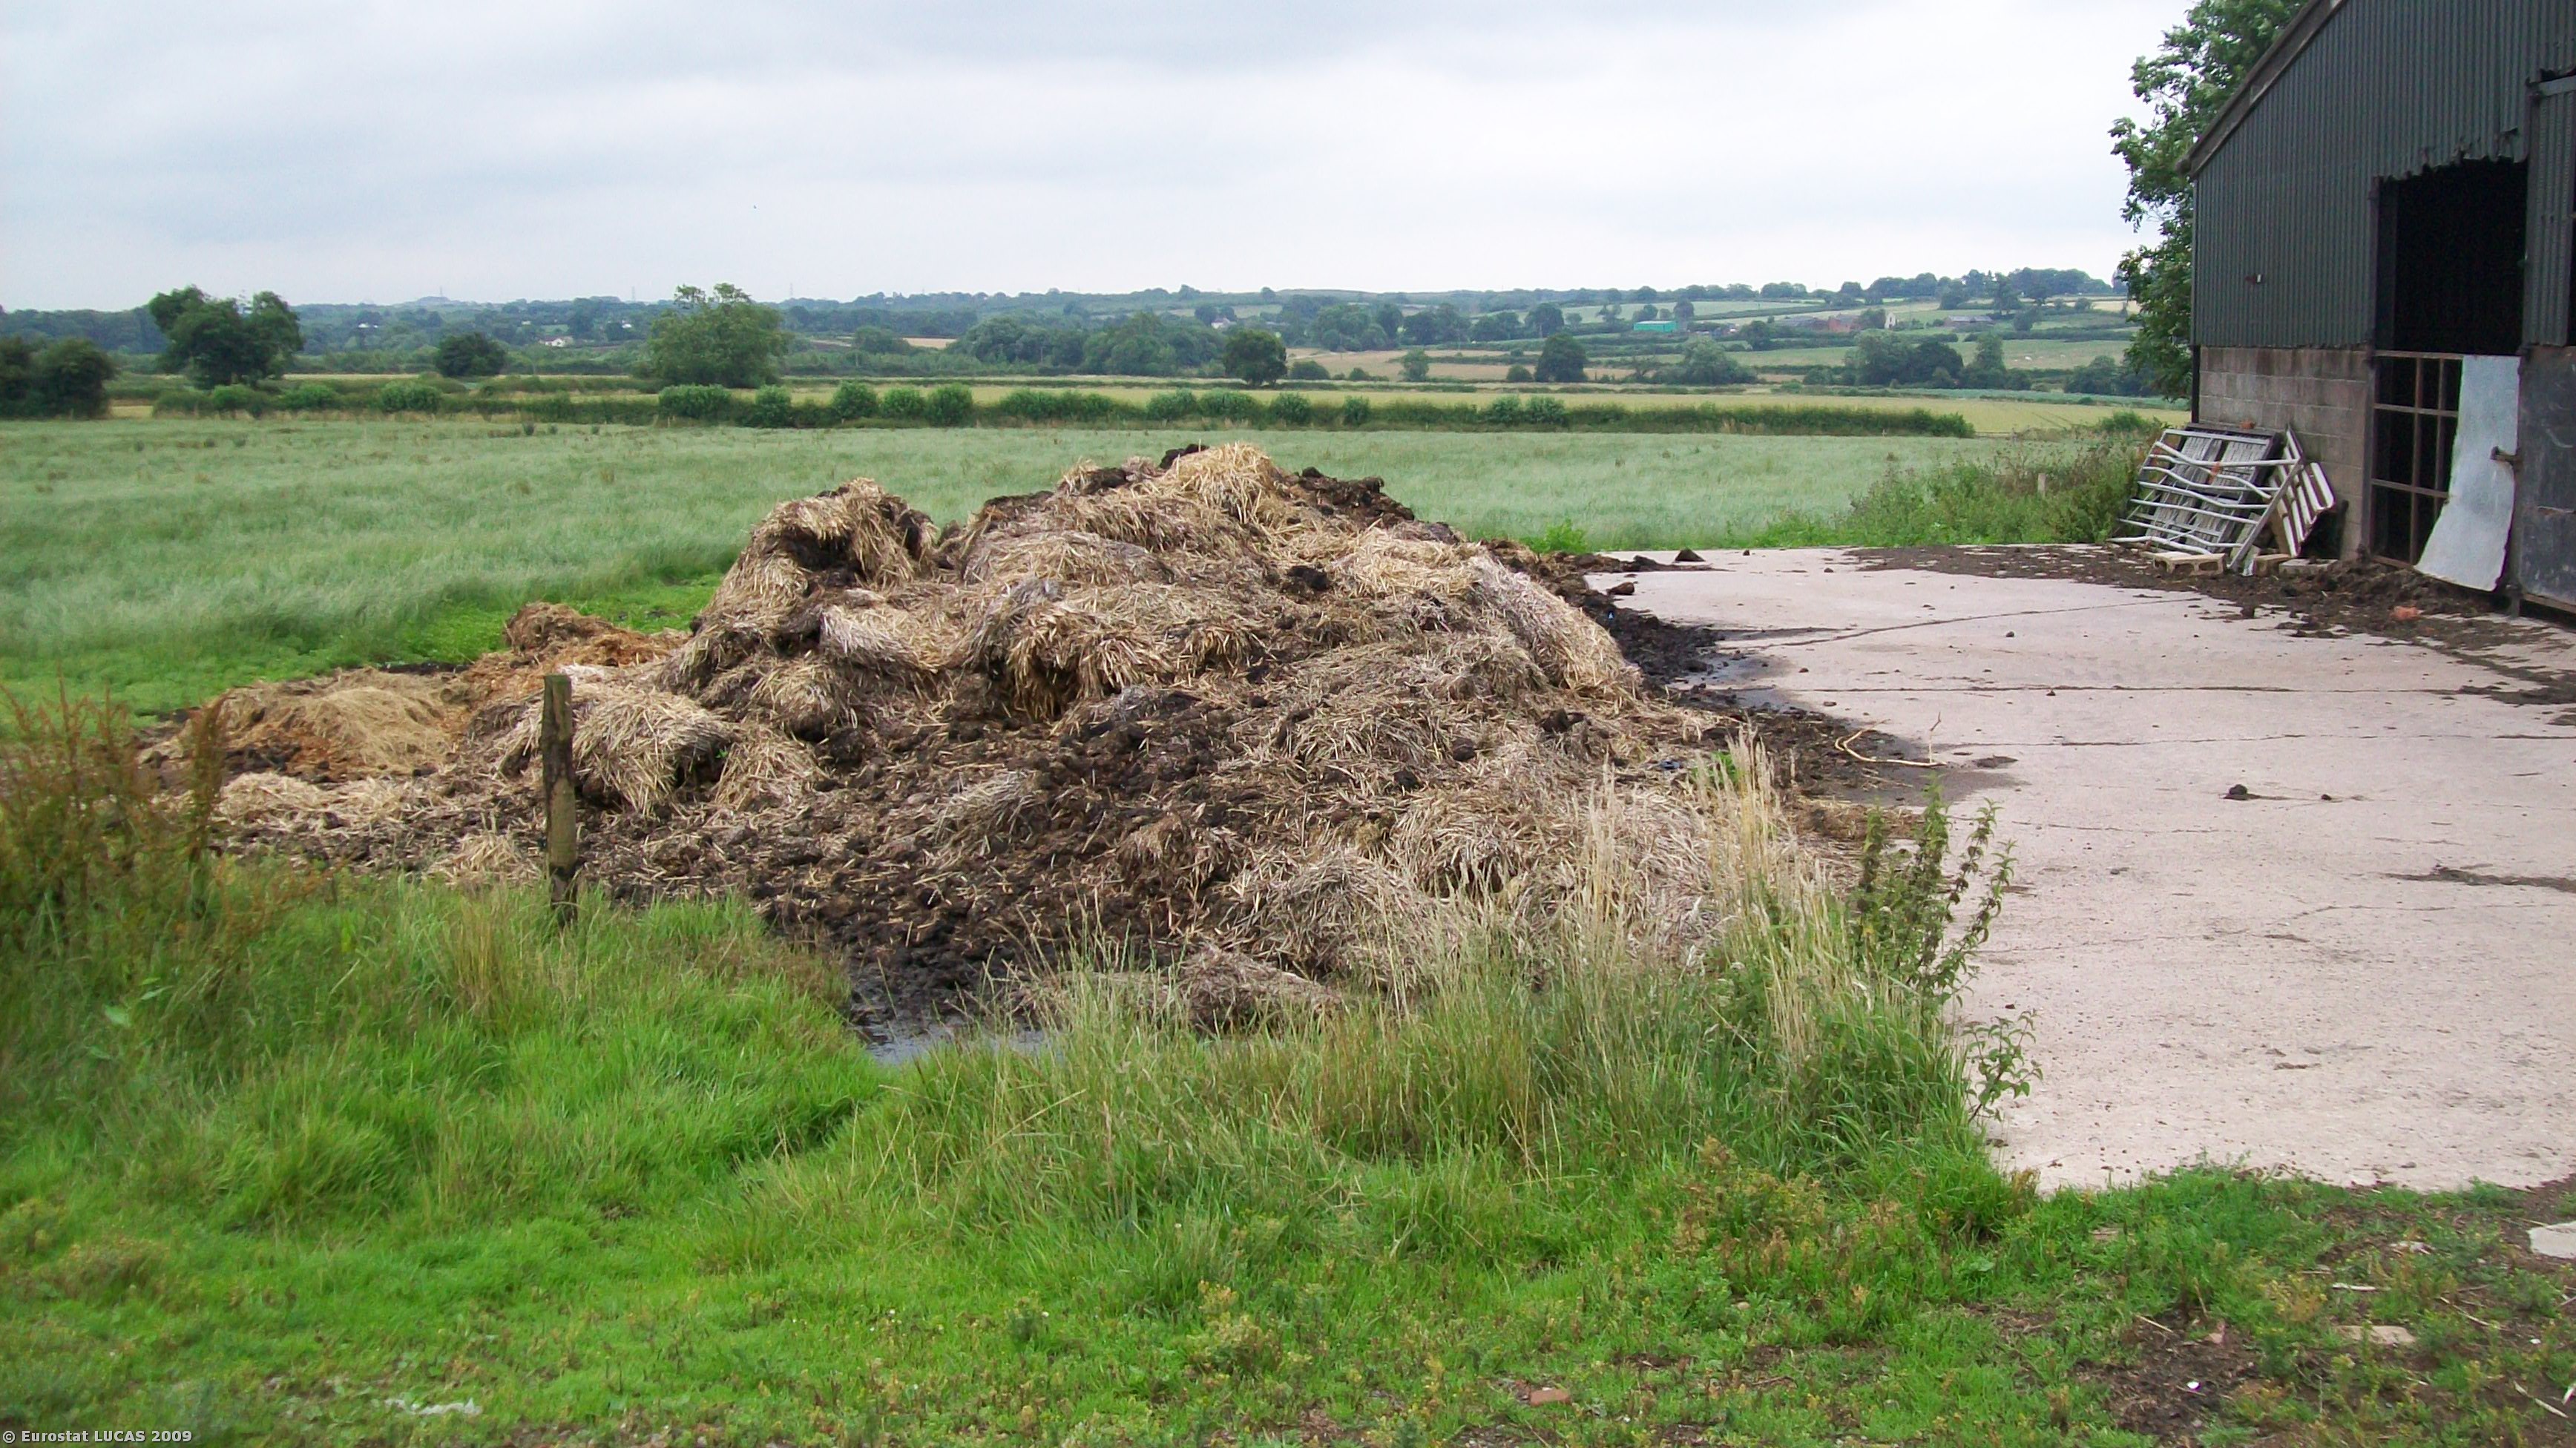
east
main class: Grassland
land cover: Grassland without tree/shrub cover
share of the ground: > 75 %
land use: Agriculture (excluding fallow land and kitchen gardens)
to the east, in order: Grassland without tree/shrub cover; Rye; Grass margins; Managed hedges; Grass margins; Common wheat
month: July
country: GB
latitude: 52.6776
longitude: -1.4237
